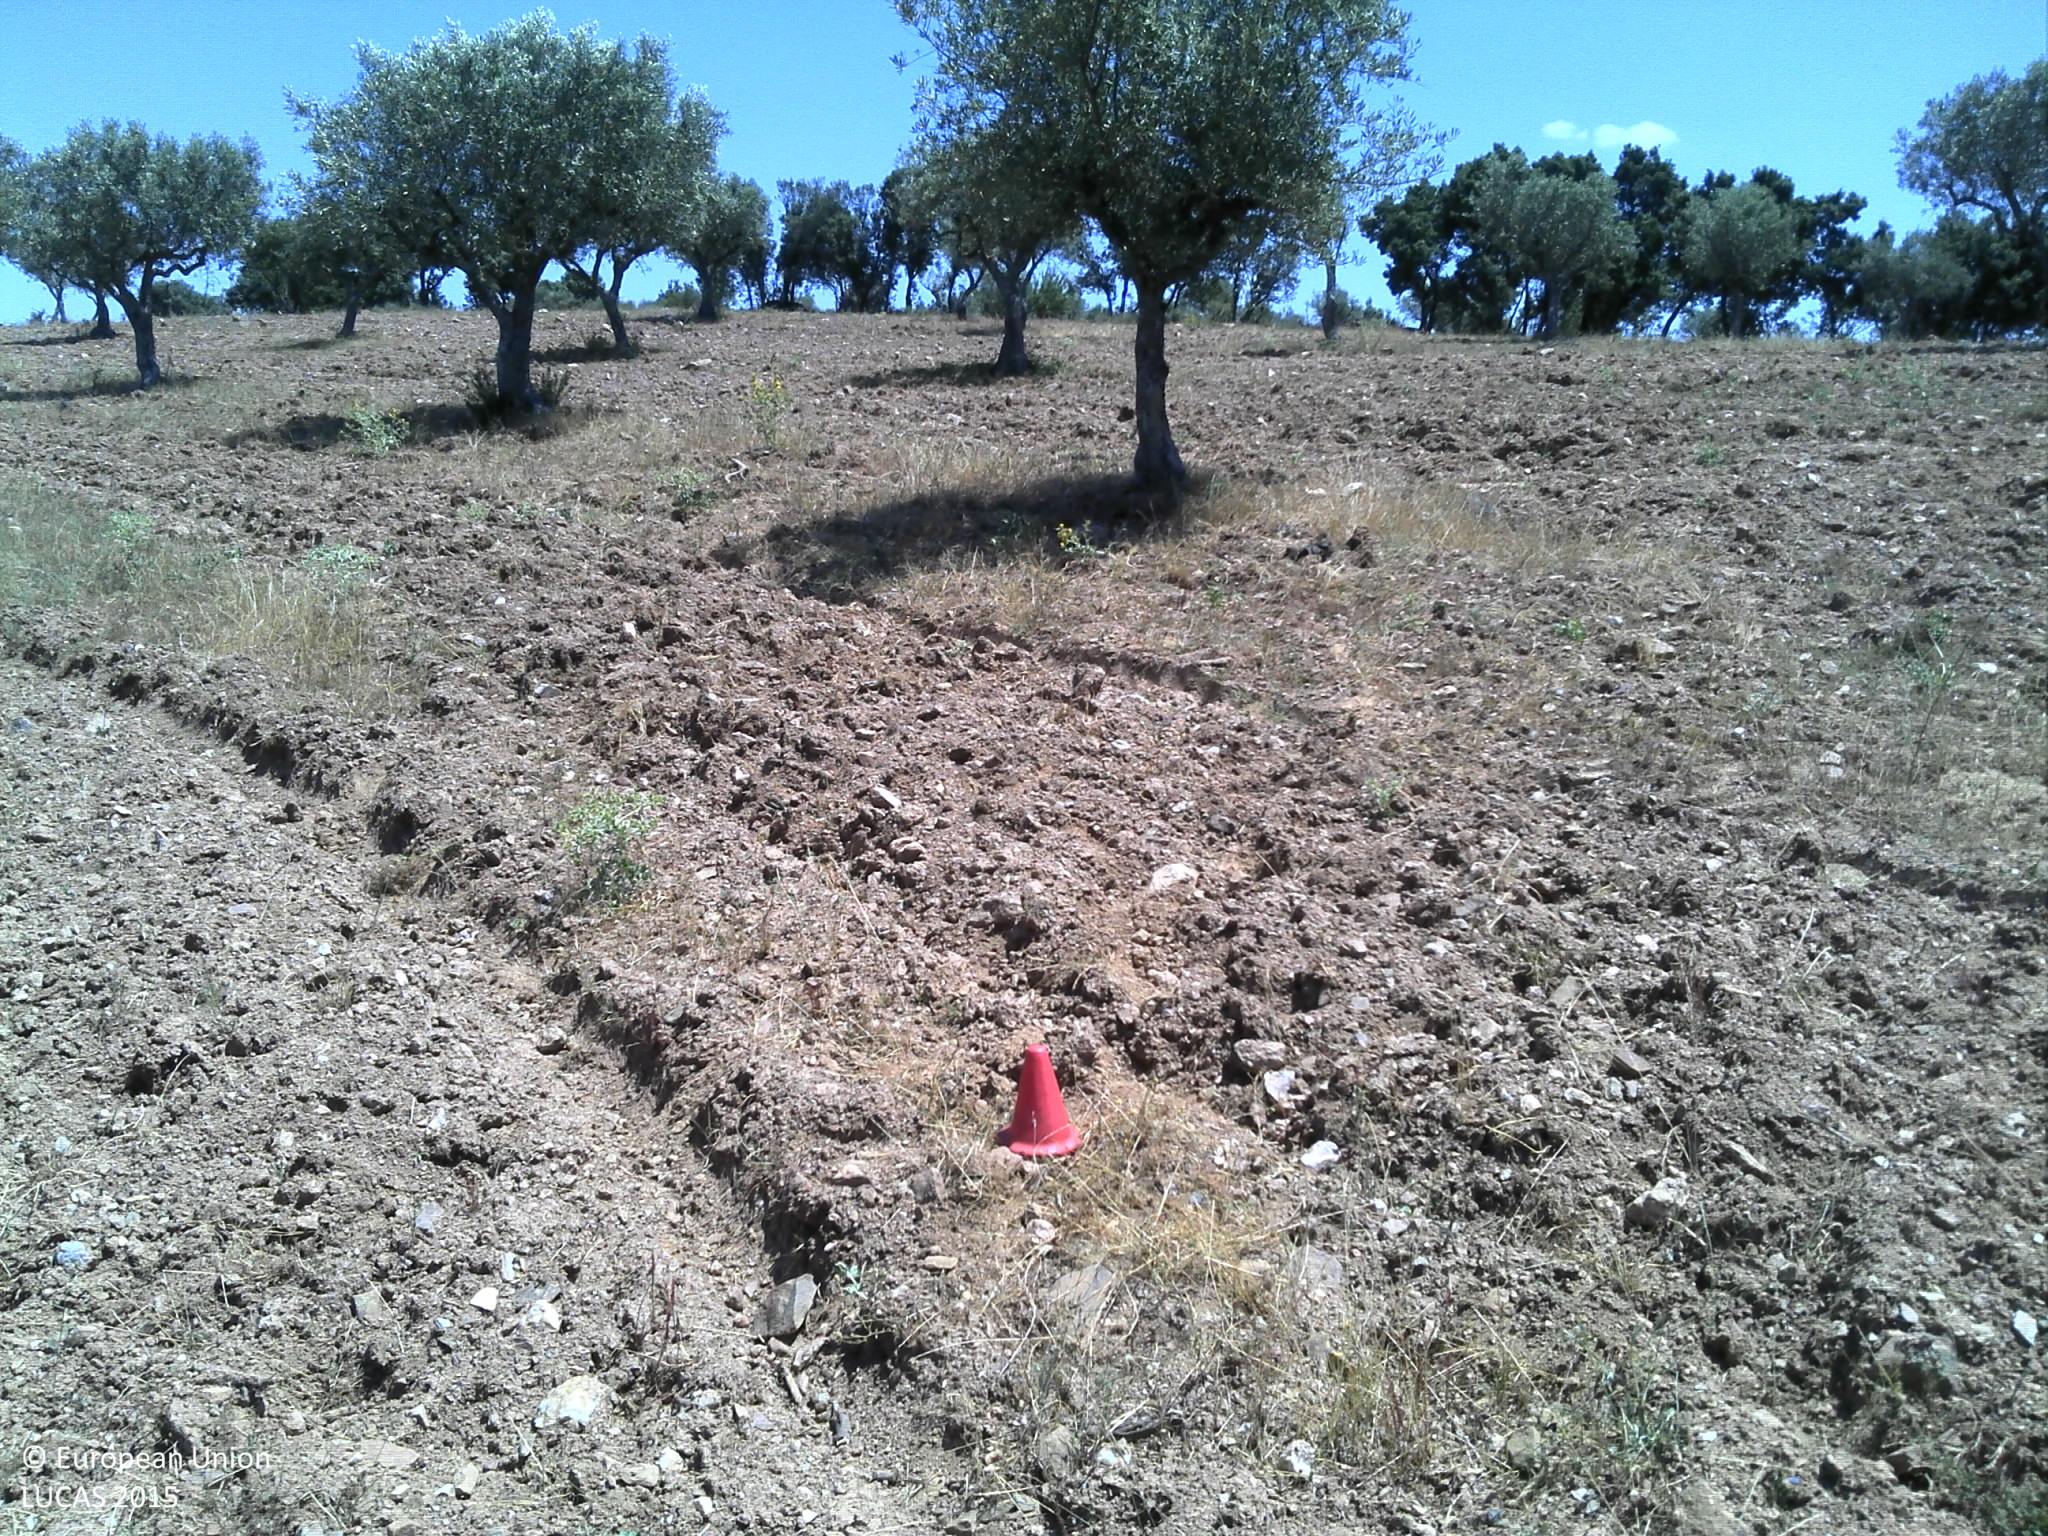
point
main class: Cropland
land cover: Olive groves
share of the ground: 10 - 25 %
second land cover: Other bare soil
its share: > 75 %
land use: Agriculture (excluding fallow land and kitchen gardens)
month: June
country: PT
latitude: 40.8395
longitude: -6.9803
